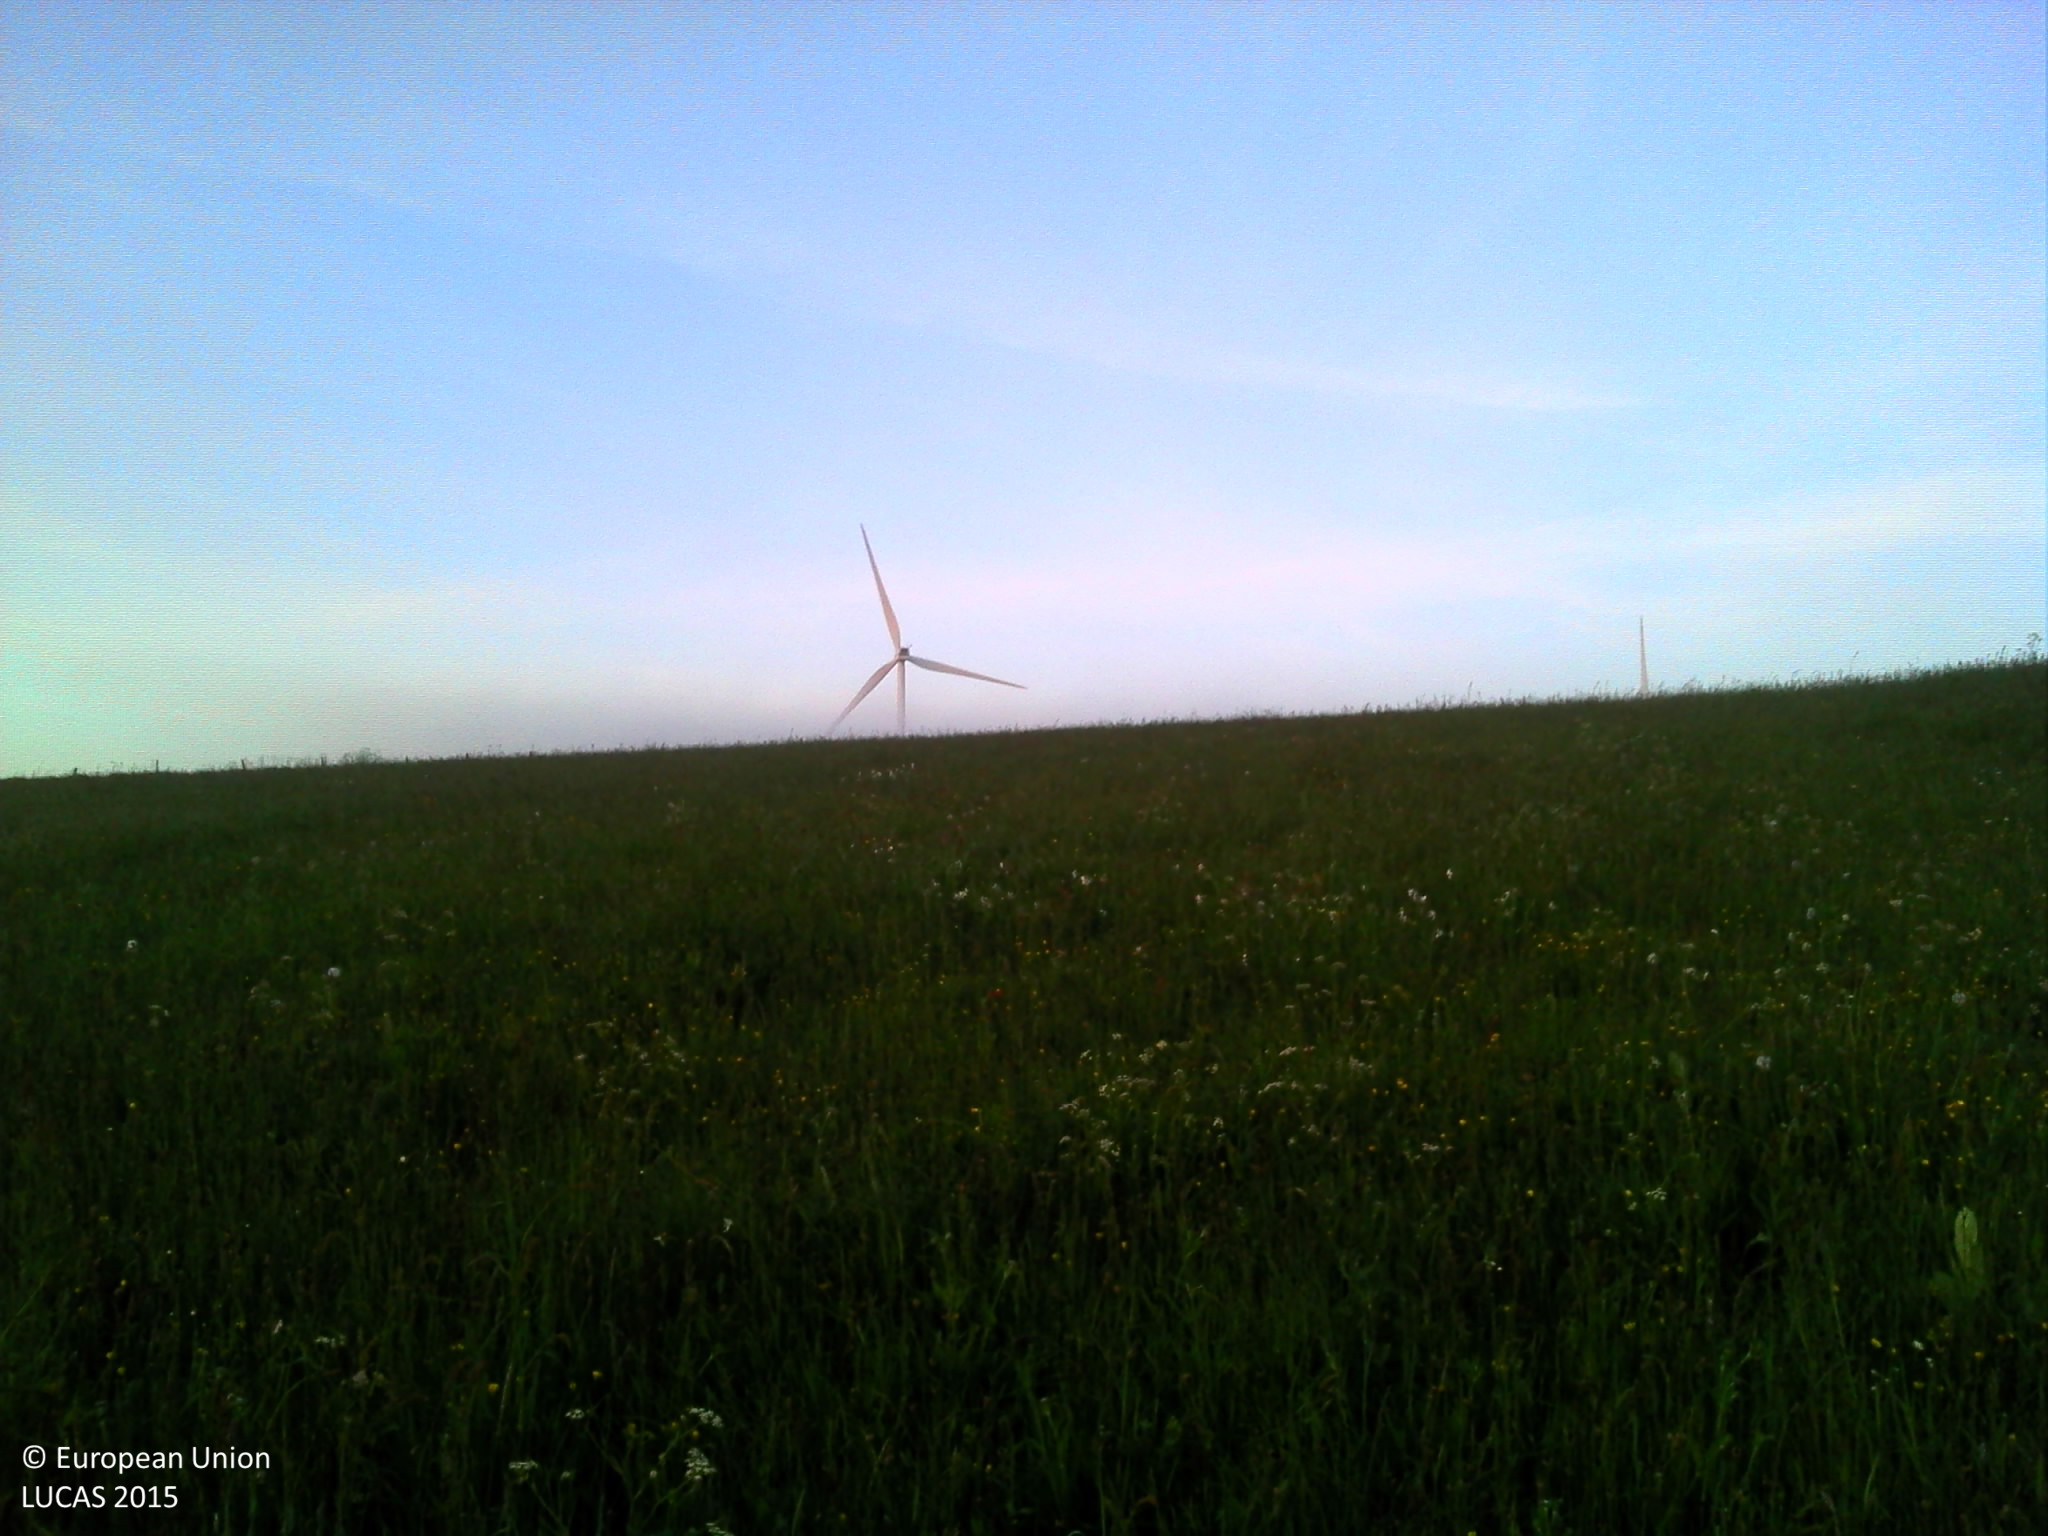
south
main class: Grassland
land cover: Grassland without tree/shrub cover
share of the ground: > 75 %
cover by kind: herbaceous plants 100 %
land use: Agriculture (excluding fallow land and kitchen gardens)
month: May
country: FR
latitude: 45.1174
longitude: 3.1250
